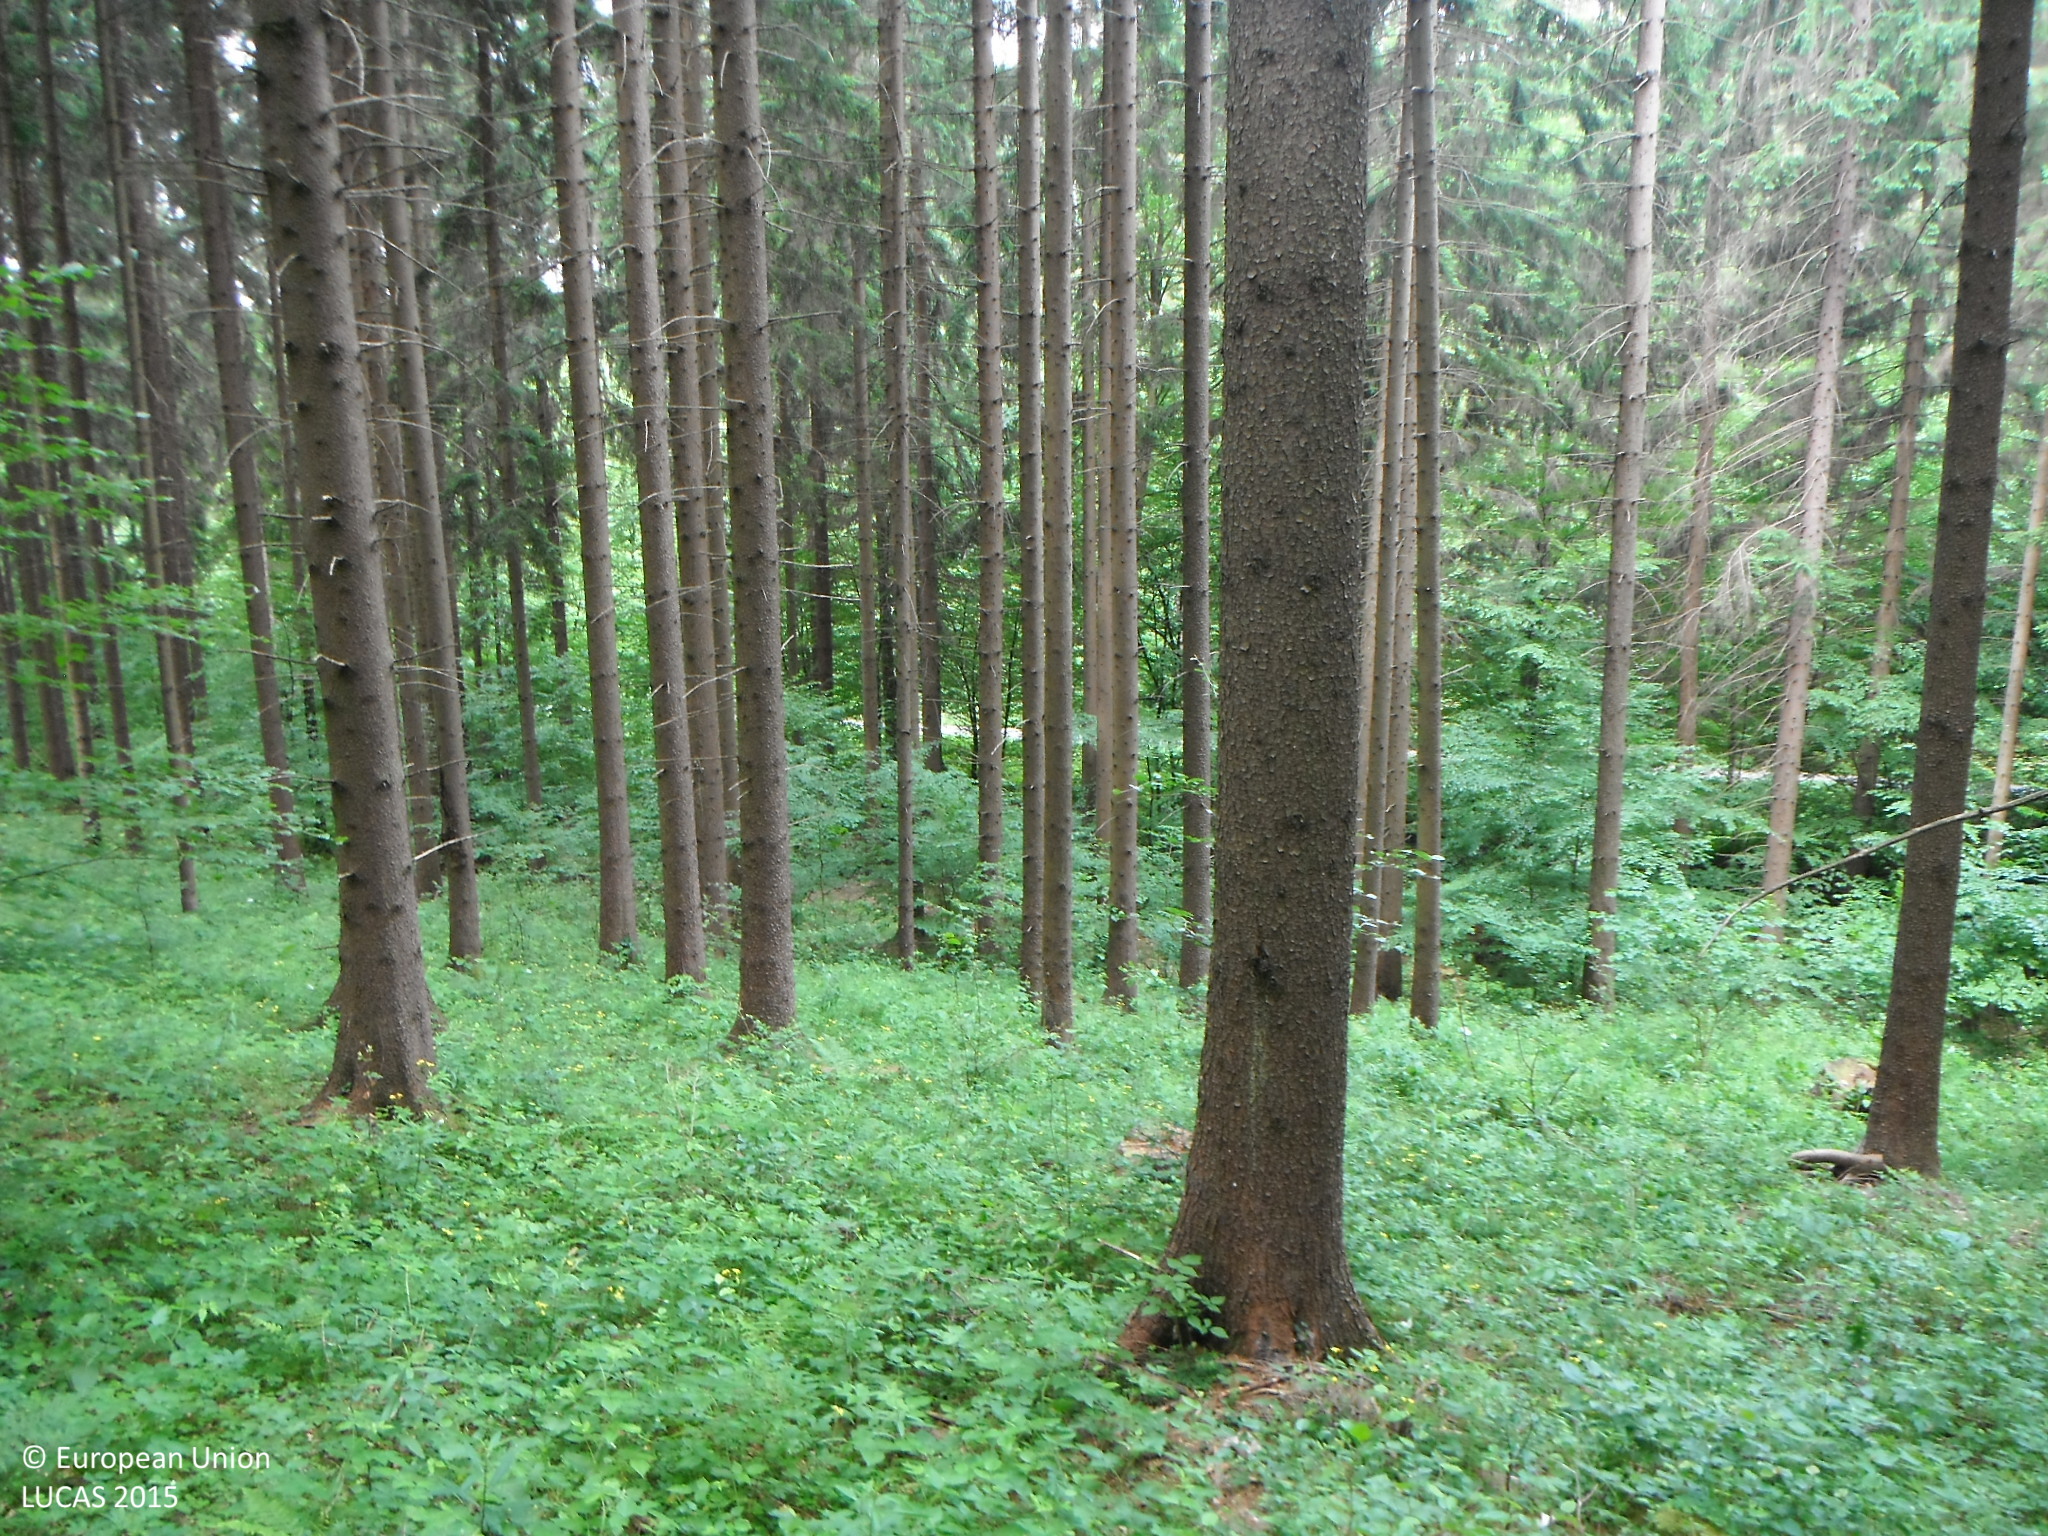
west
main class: Woodland
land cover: Spruce dominated coniferous woodland
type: alpine coniferous forest
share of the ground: > 75 %
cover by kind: coniferous forest trees 90 %, shrubs 5 %, herbaceous plants 5 %
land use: Forestry
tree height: > 5 m
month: June
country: SK
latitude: 48.6206
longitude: 19.3709
